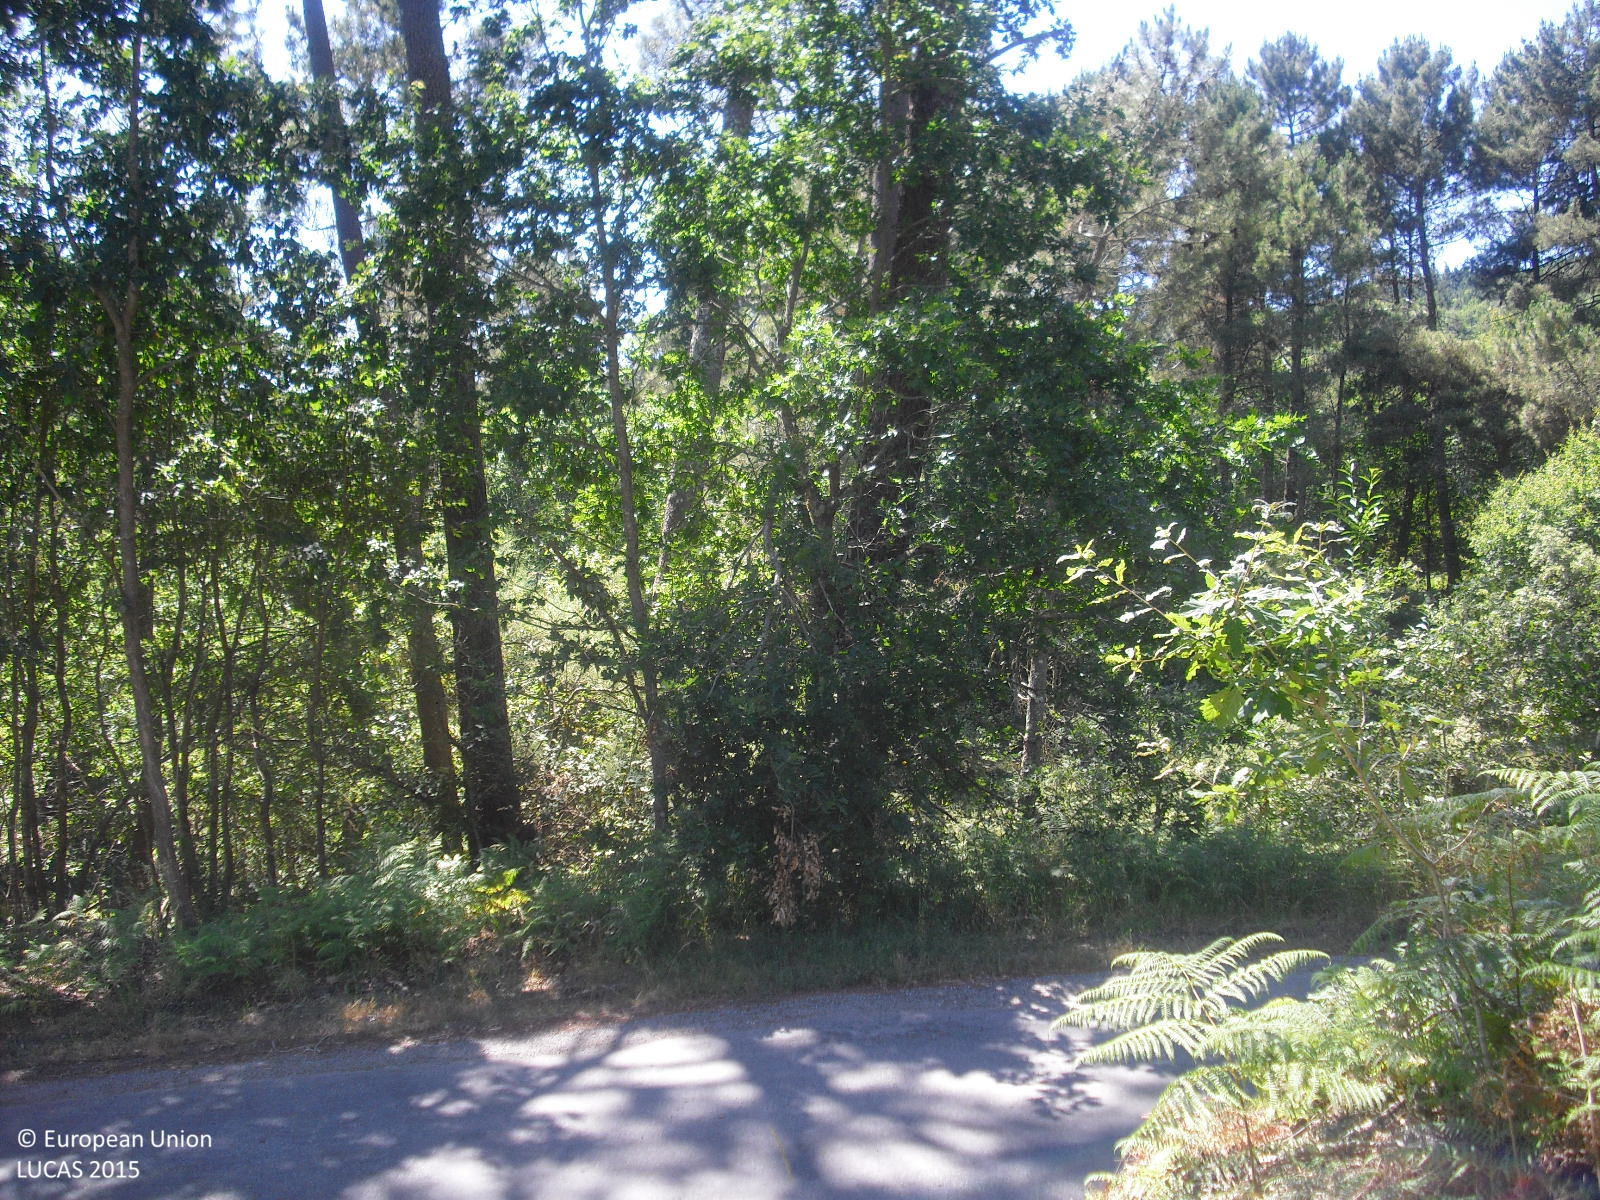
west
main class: Woodland
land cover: Pine dominated mixed woodland
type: hemiboreal forest and nemoral coniferous forest and mixed broadleaved-coniferous forest
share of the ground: 25 - 50 %
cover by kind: coniferous forest trees 40 %, shrubs 35 %, broadleaved forest trees 15 %, herbaceous plants 10 %
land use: Forestry
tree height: > 5 m
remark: Clear cut
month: June
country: ES
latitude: 42.4517
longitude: -7.7675
